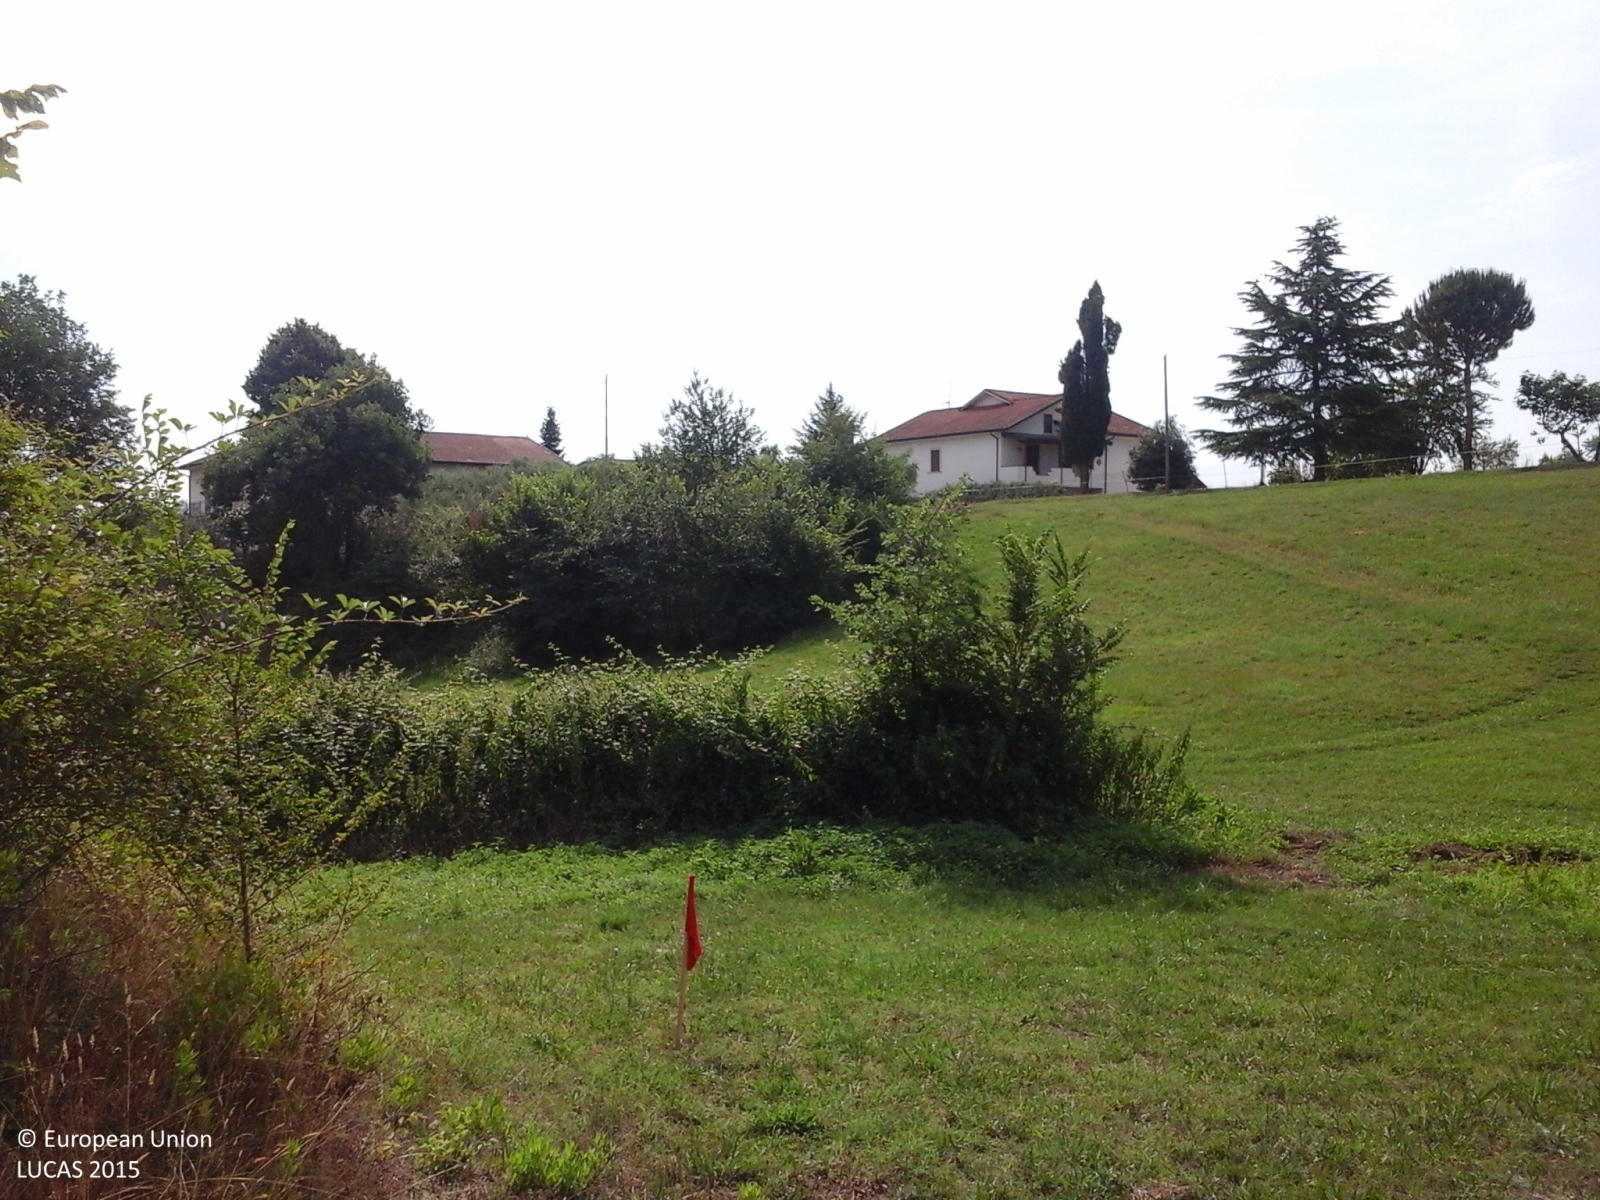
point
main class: Grassland
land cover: Grassland without tree/shrub cover
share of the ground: > 75 %
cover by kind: herbaceous plants 100 %
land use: Agriculture (excluding fallow land and kitchen gardens)
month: June
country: IT
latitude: 41.5841
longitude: 13.4056
